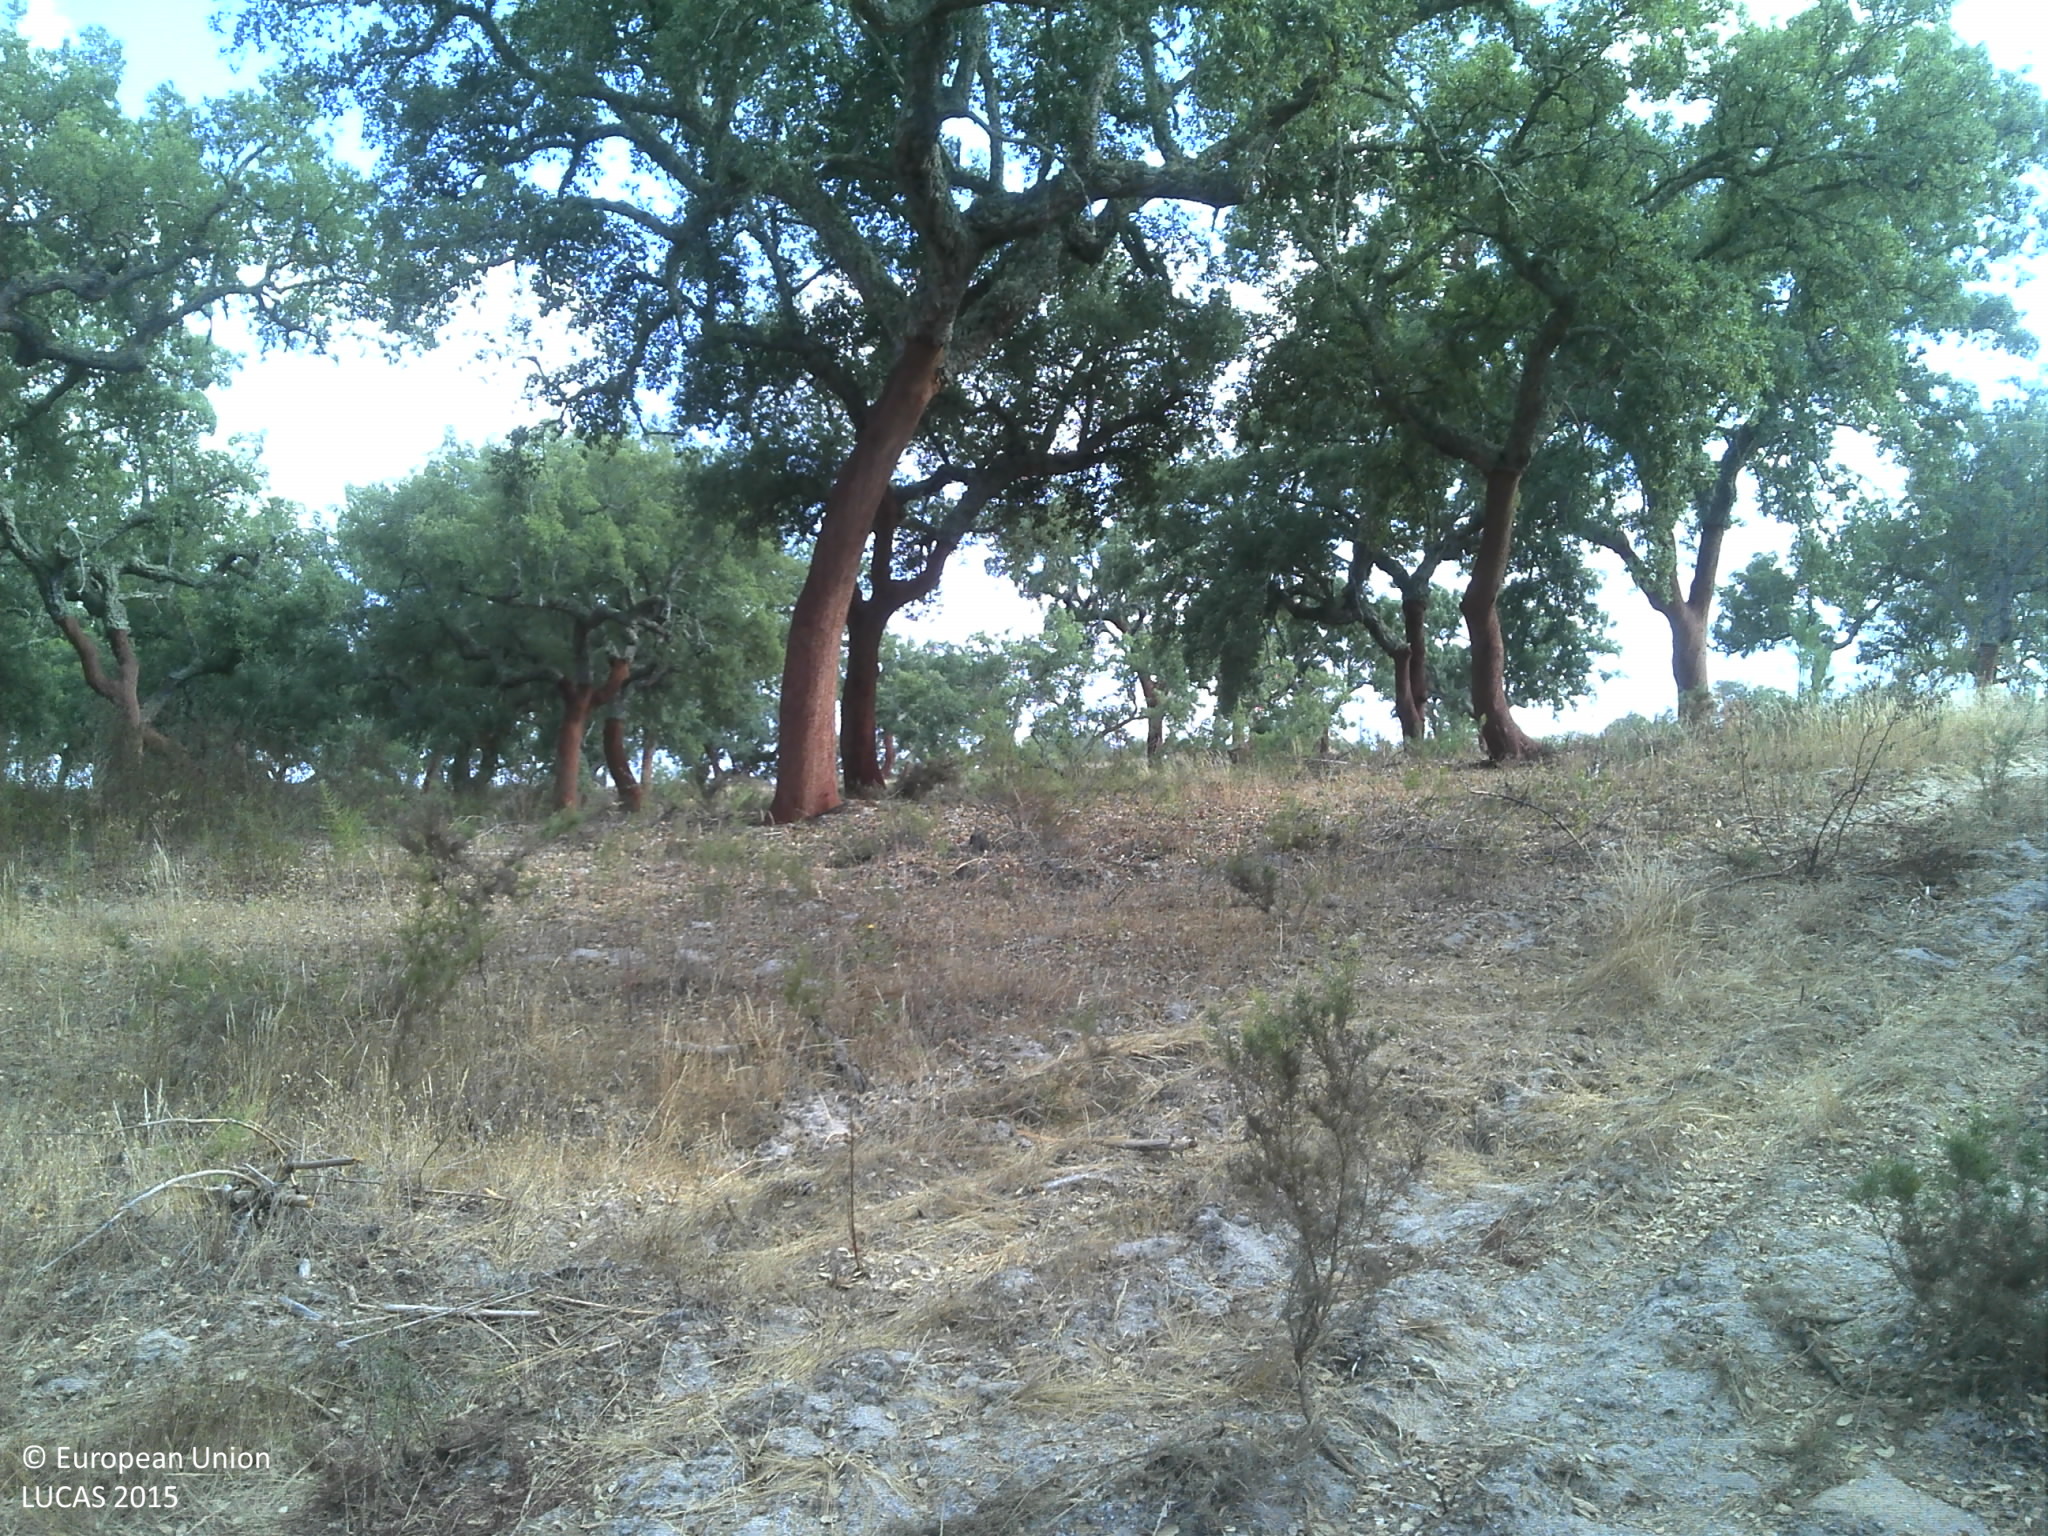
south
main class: Woodland
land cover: Broadleaved woodland
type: broadleaved evergreen forest
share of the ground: 50 - 75 %
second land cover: Grassland without tree/shrub cover
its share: 25 - 50 %
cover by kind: broadleaved forest trees 50 %, herbaceous plants 25 %, unconsolidated bare surface 25 %
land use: Forestry
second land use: Agriculture (excluding fallow land and kitchen gardens)
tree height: > 5 m
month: July
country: PT
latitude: 38.9019
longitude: -8.1908
